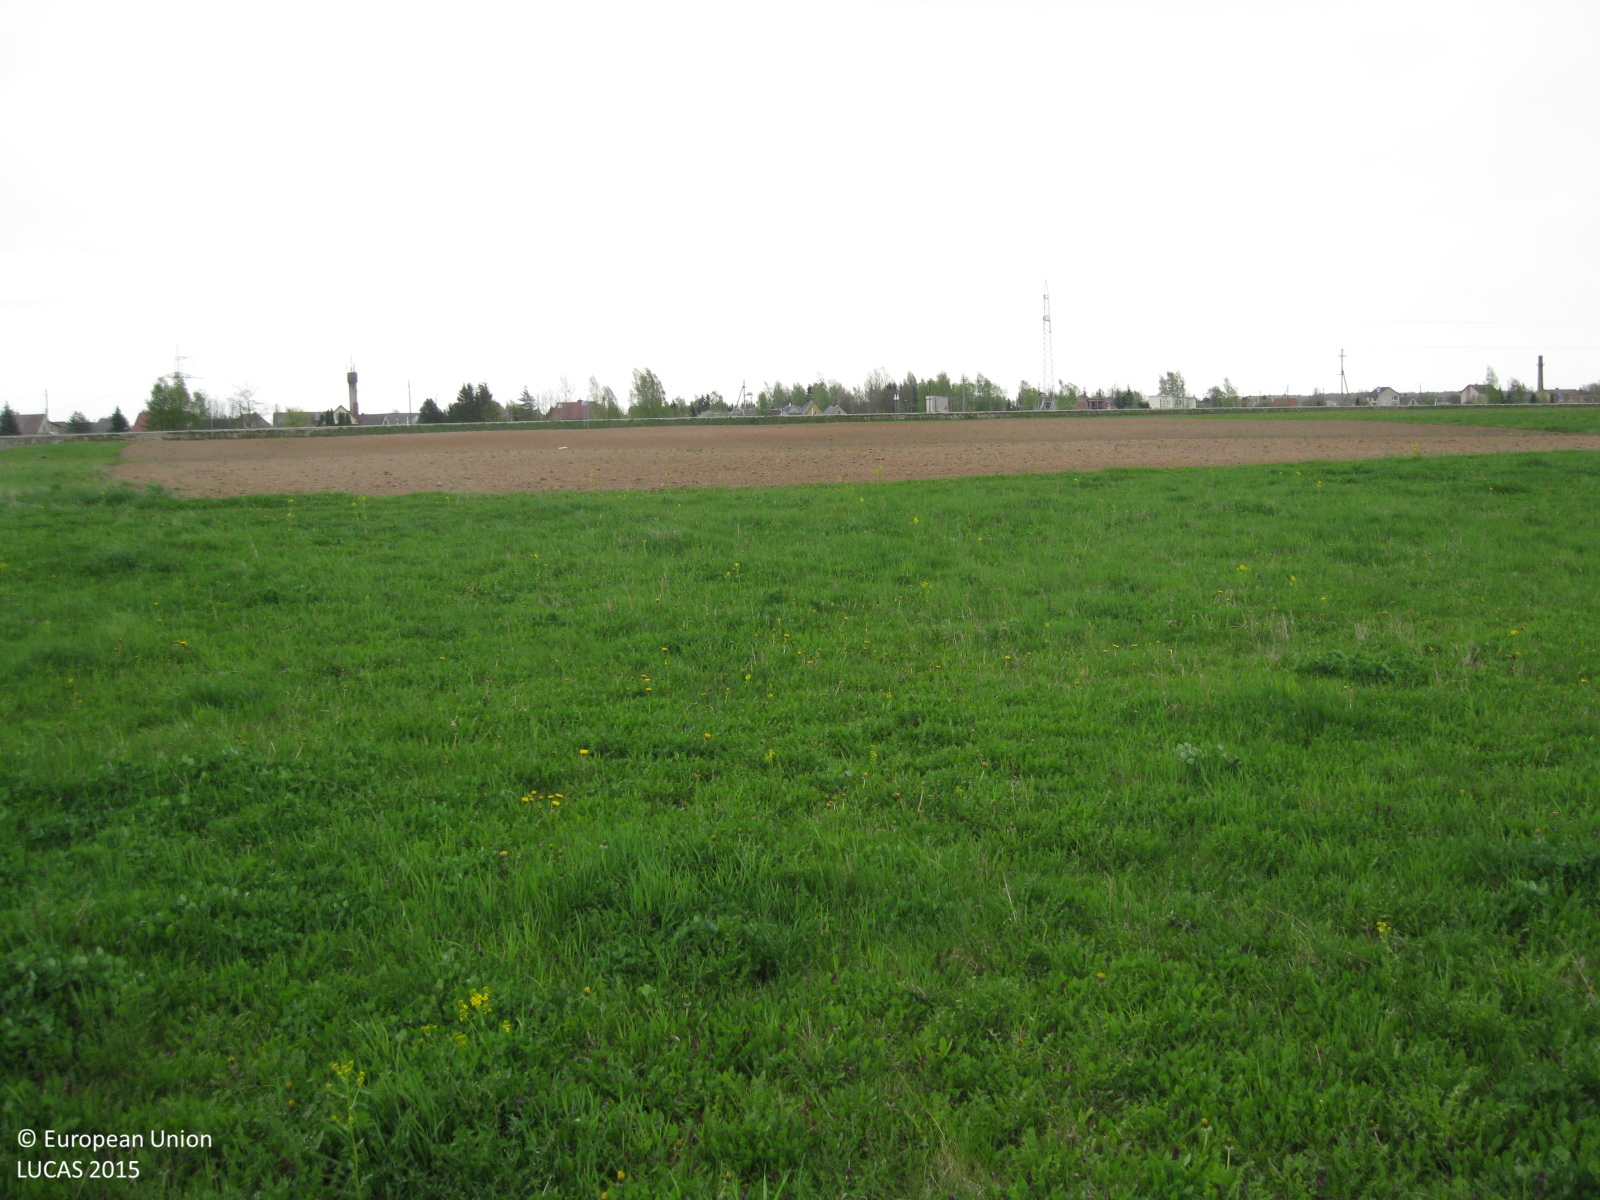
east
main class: Grassland
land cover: Grassland without tree/shrub cover
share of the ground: > 75 %
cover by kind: herbaceous plants 95 %, unconsolidated bare surface 5 %
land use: Agriculture (excluding fallow land and kitchen gardens)
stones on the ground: < 10 %
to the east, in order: Grassland without tree/shrub cover; Common wheat; Grassland without tree/shrub cover; Paved roads, cycling and walking lanes; Grassland without tree/shrub cover
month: May
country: LT
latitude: 56.1308
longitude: 24.4644
